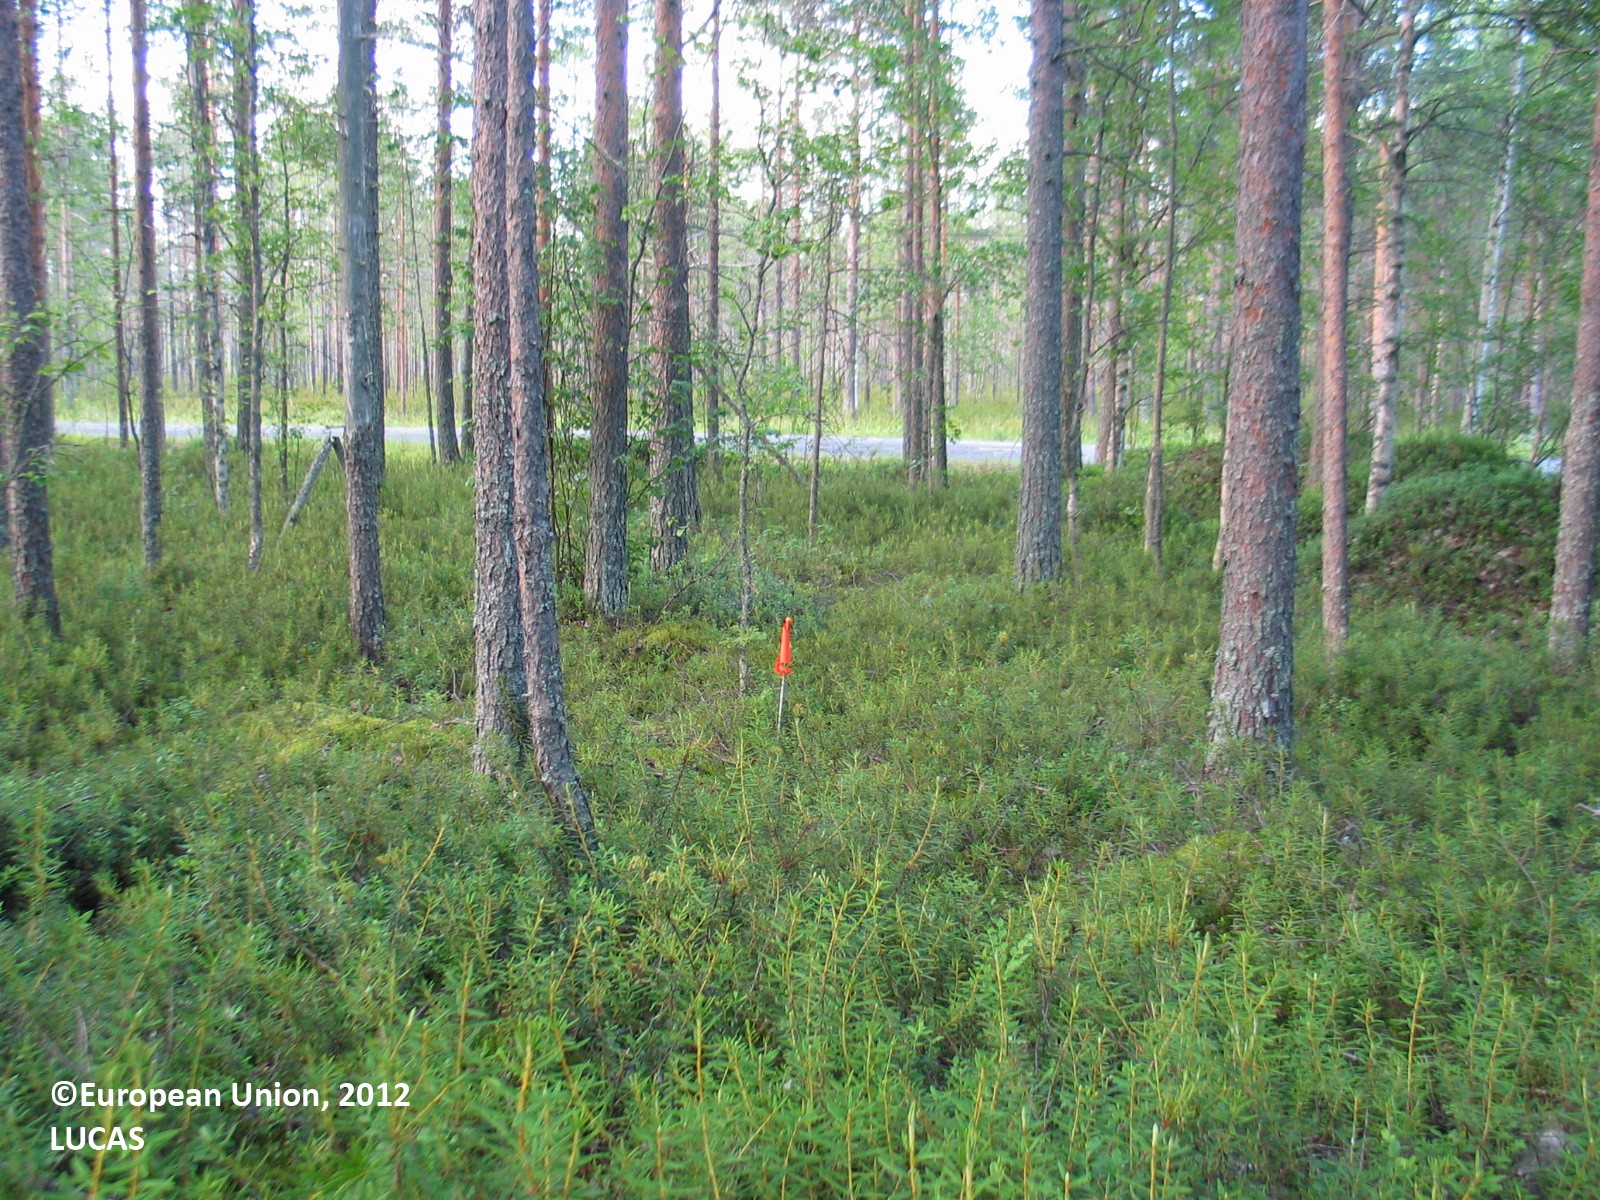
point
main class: Woodland
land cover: Pine dominated coniferous woodland
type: mire and swamp forests
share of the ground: 50 - 75 %
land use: Forestry
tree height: > 5 m
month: July
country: FI
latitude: 64.6559
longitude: 26.5070
